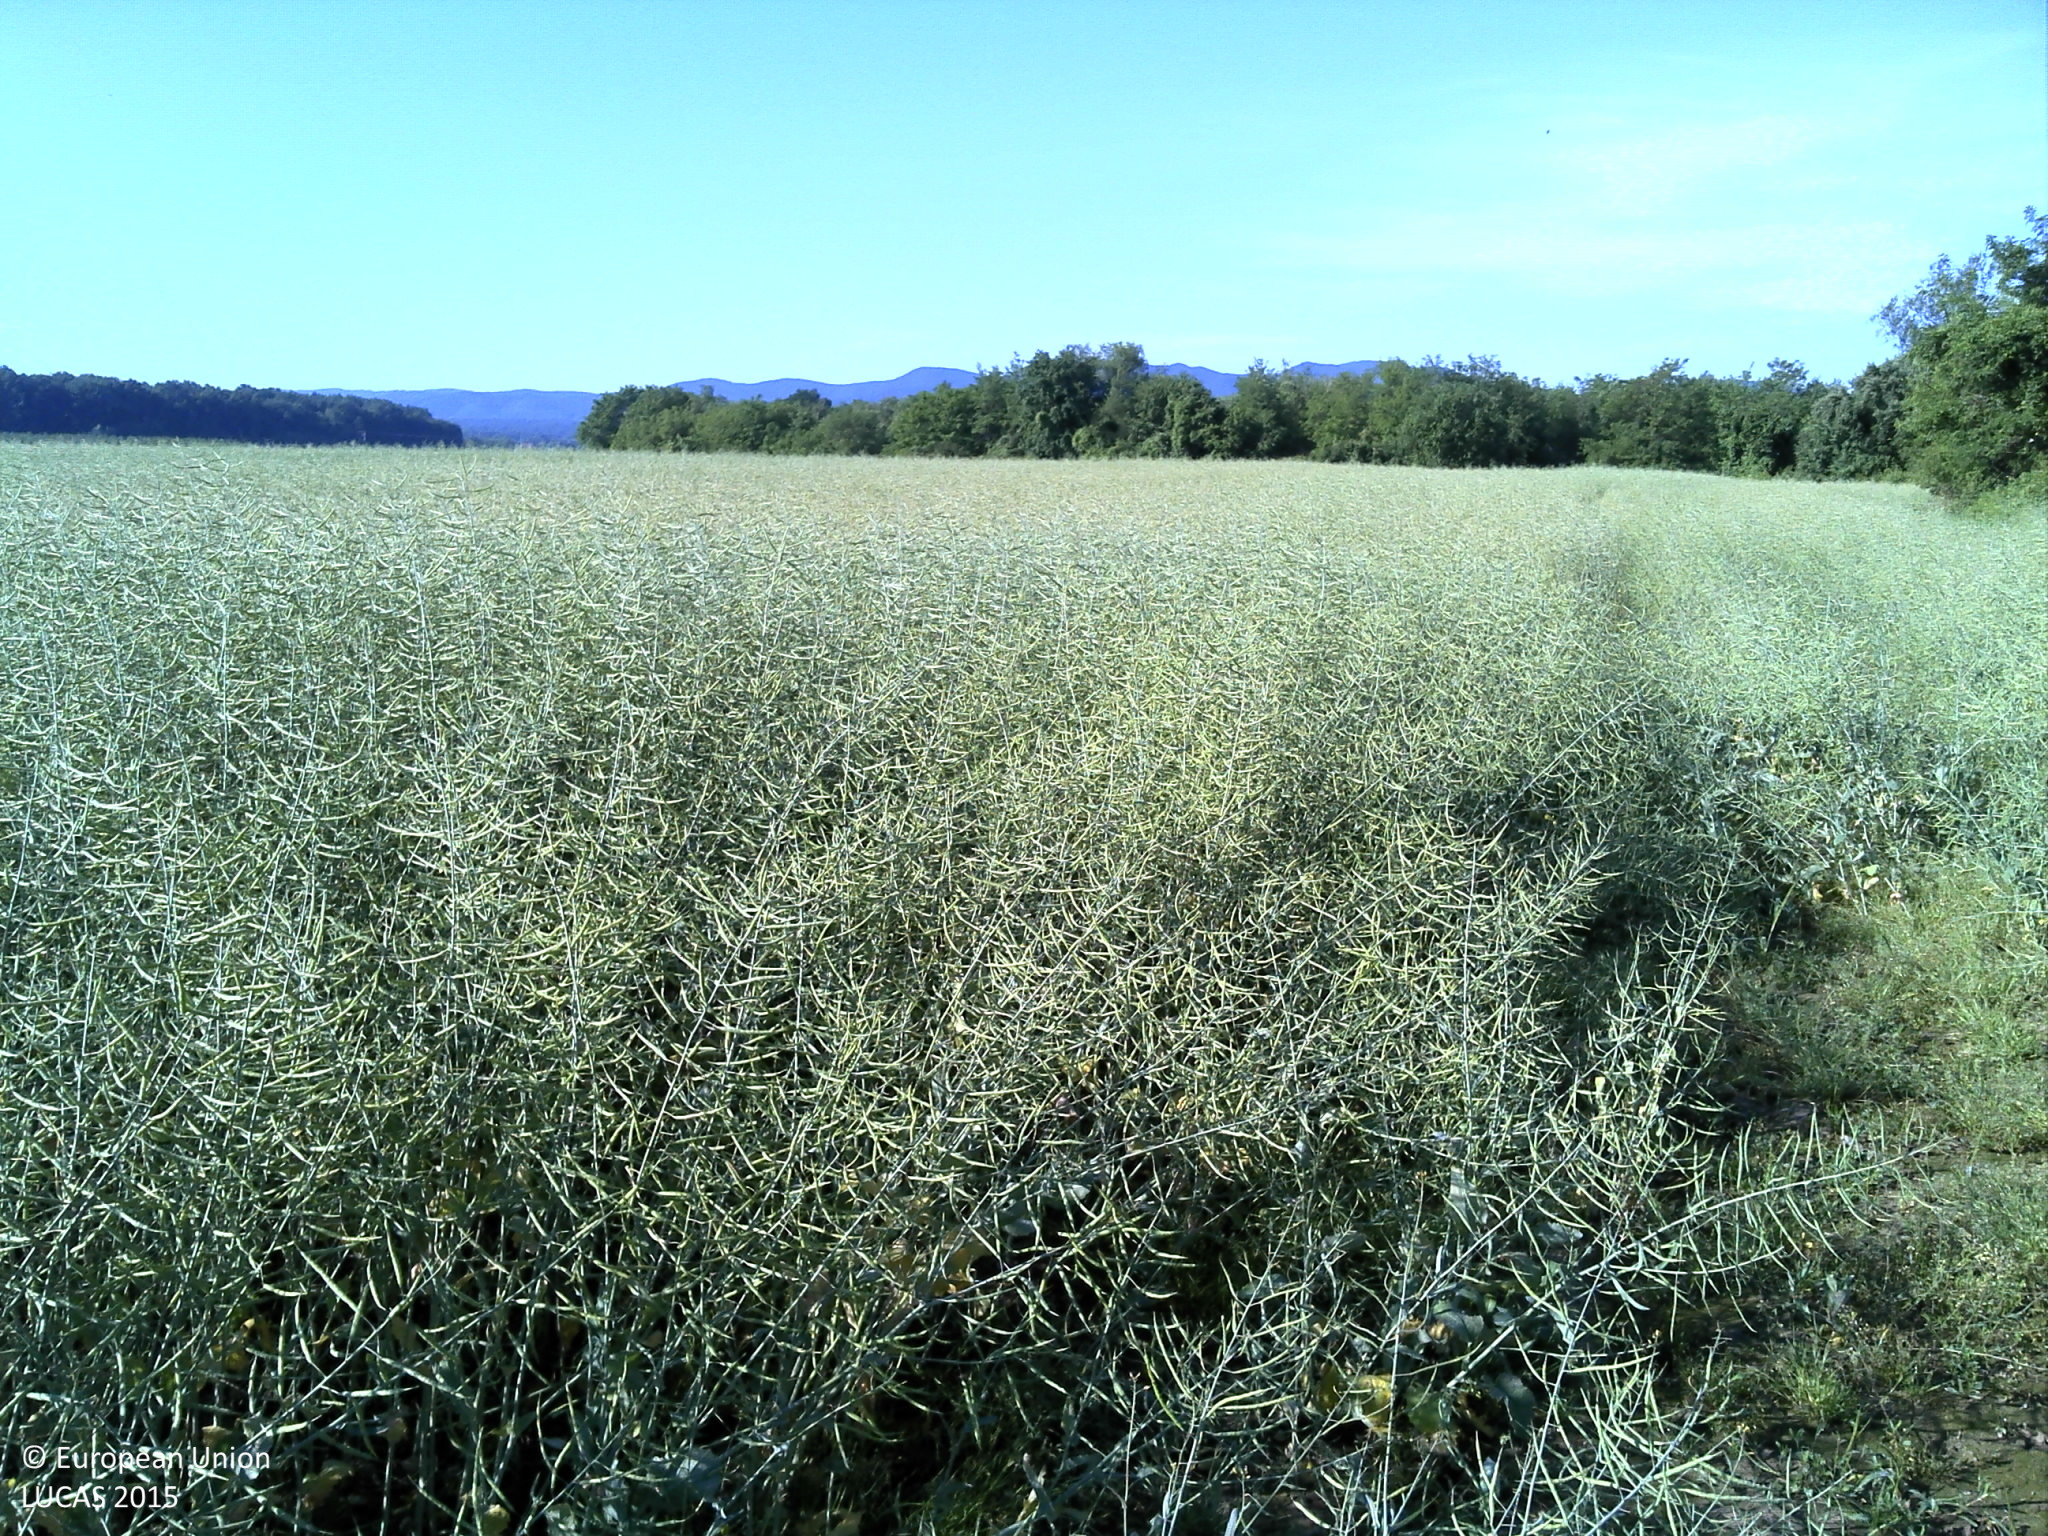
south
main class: Cropland
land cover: Rape and turnip rape
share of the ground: > 75 %
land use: Agriculture (excluding fallow land and kitchen gardens)
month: May
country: HR
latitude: 45.5694
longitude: 17.9094
